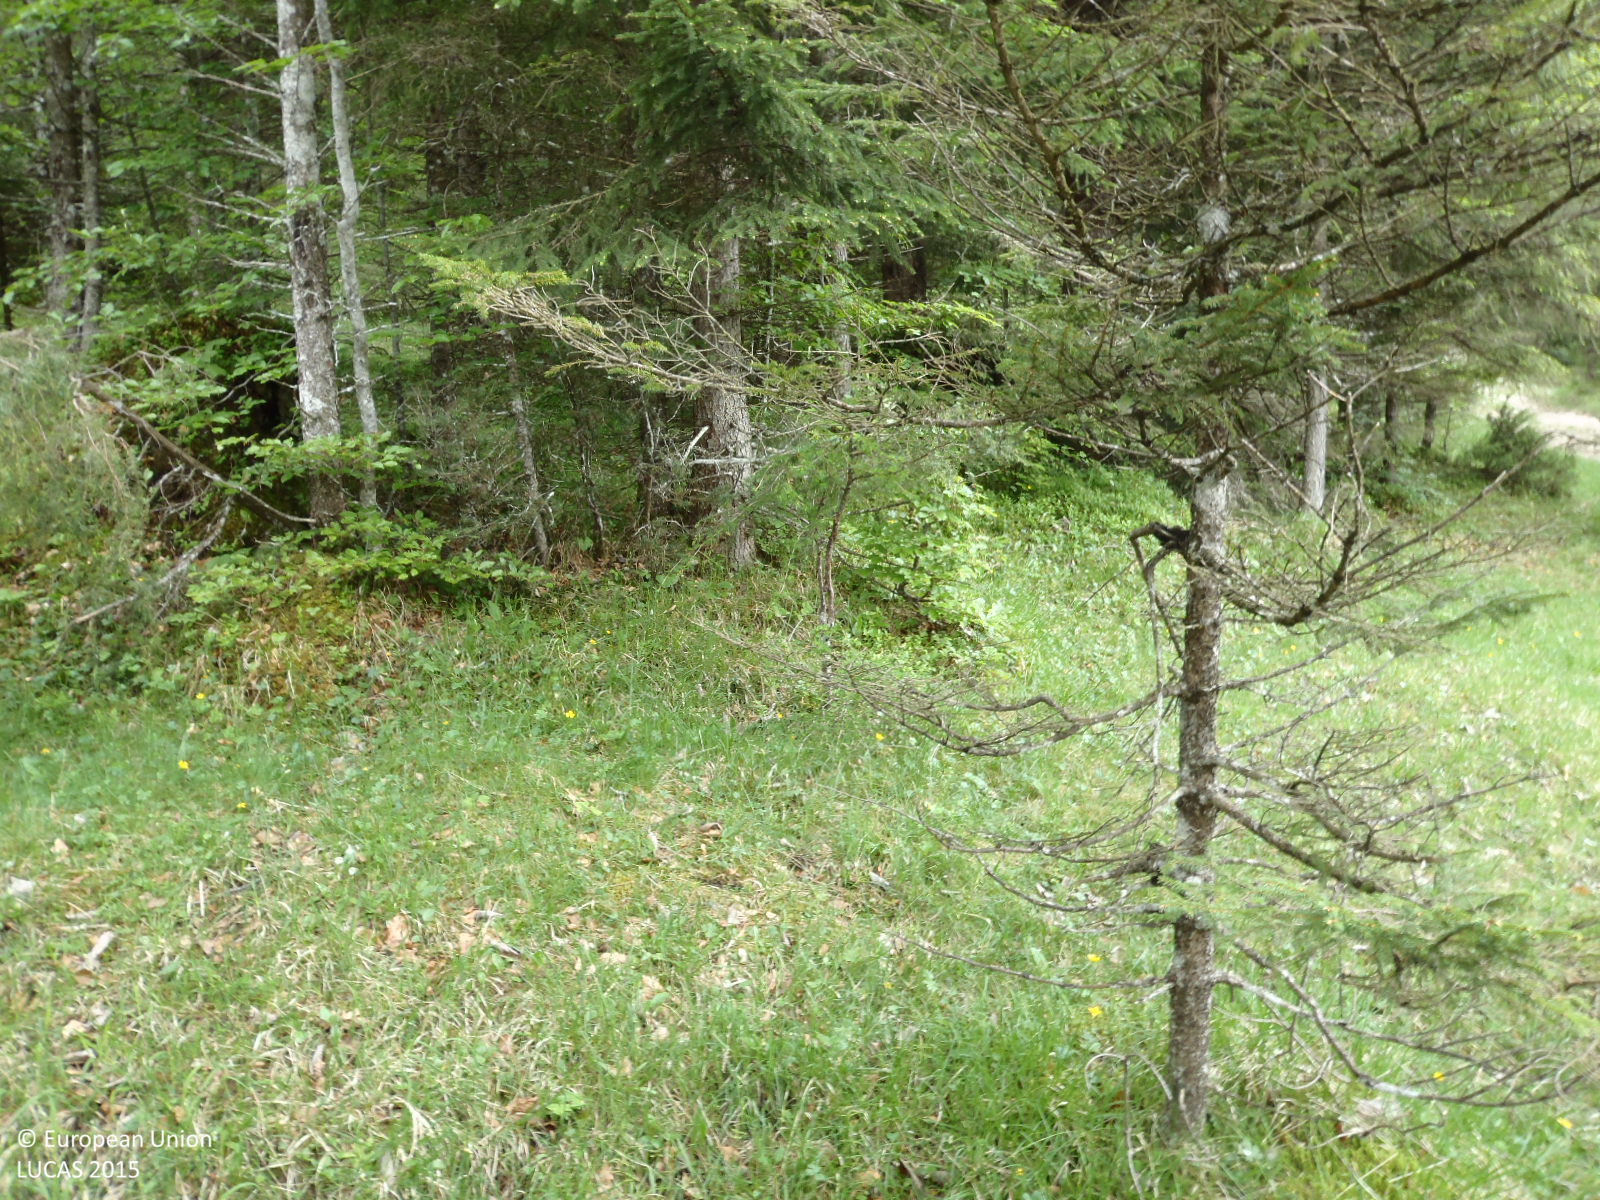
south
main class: Woodland
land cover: Other mixed woodland
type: alpine coniferous forest
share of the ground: > 75 %
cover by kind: coniferous forest trees 65 %, broadleaved forest trees 25 %, herbaceous plants 10 %
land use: Forestry
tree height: > 5 m
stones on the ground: < 10 %
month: May
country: AT
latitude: 47.5065
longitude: 11.8175
